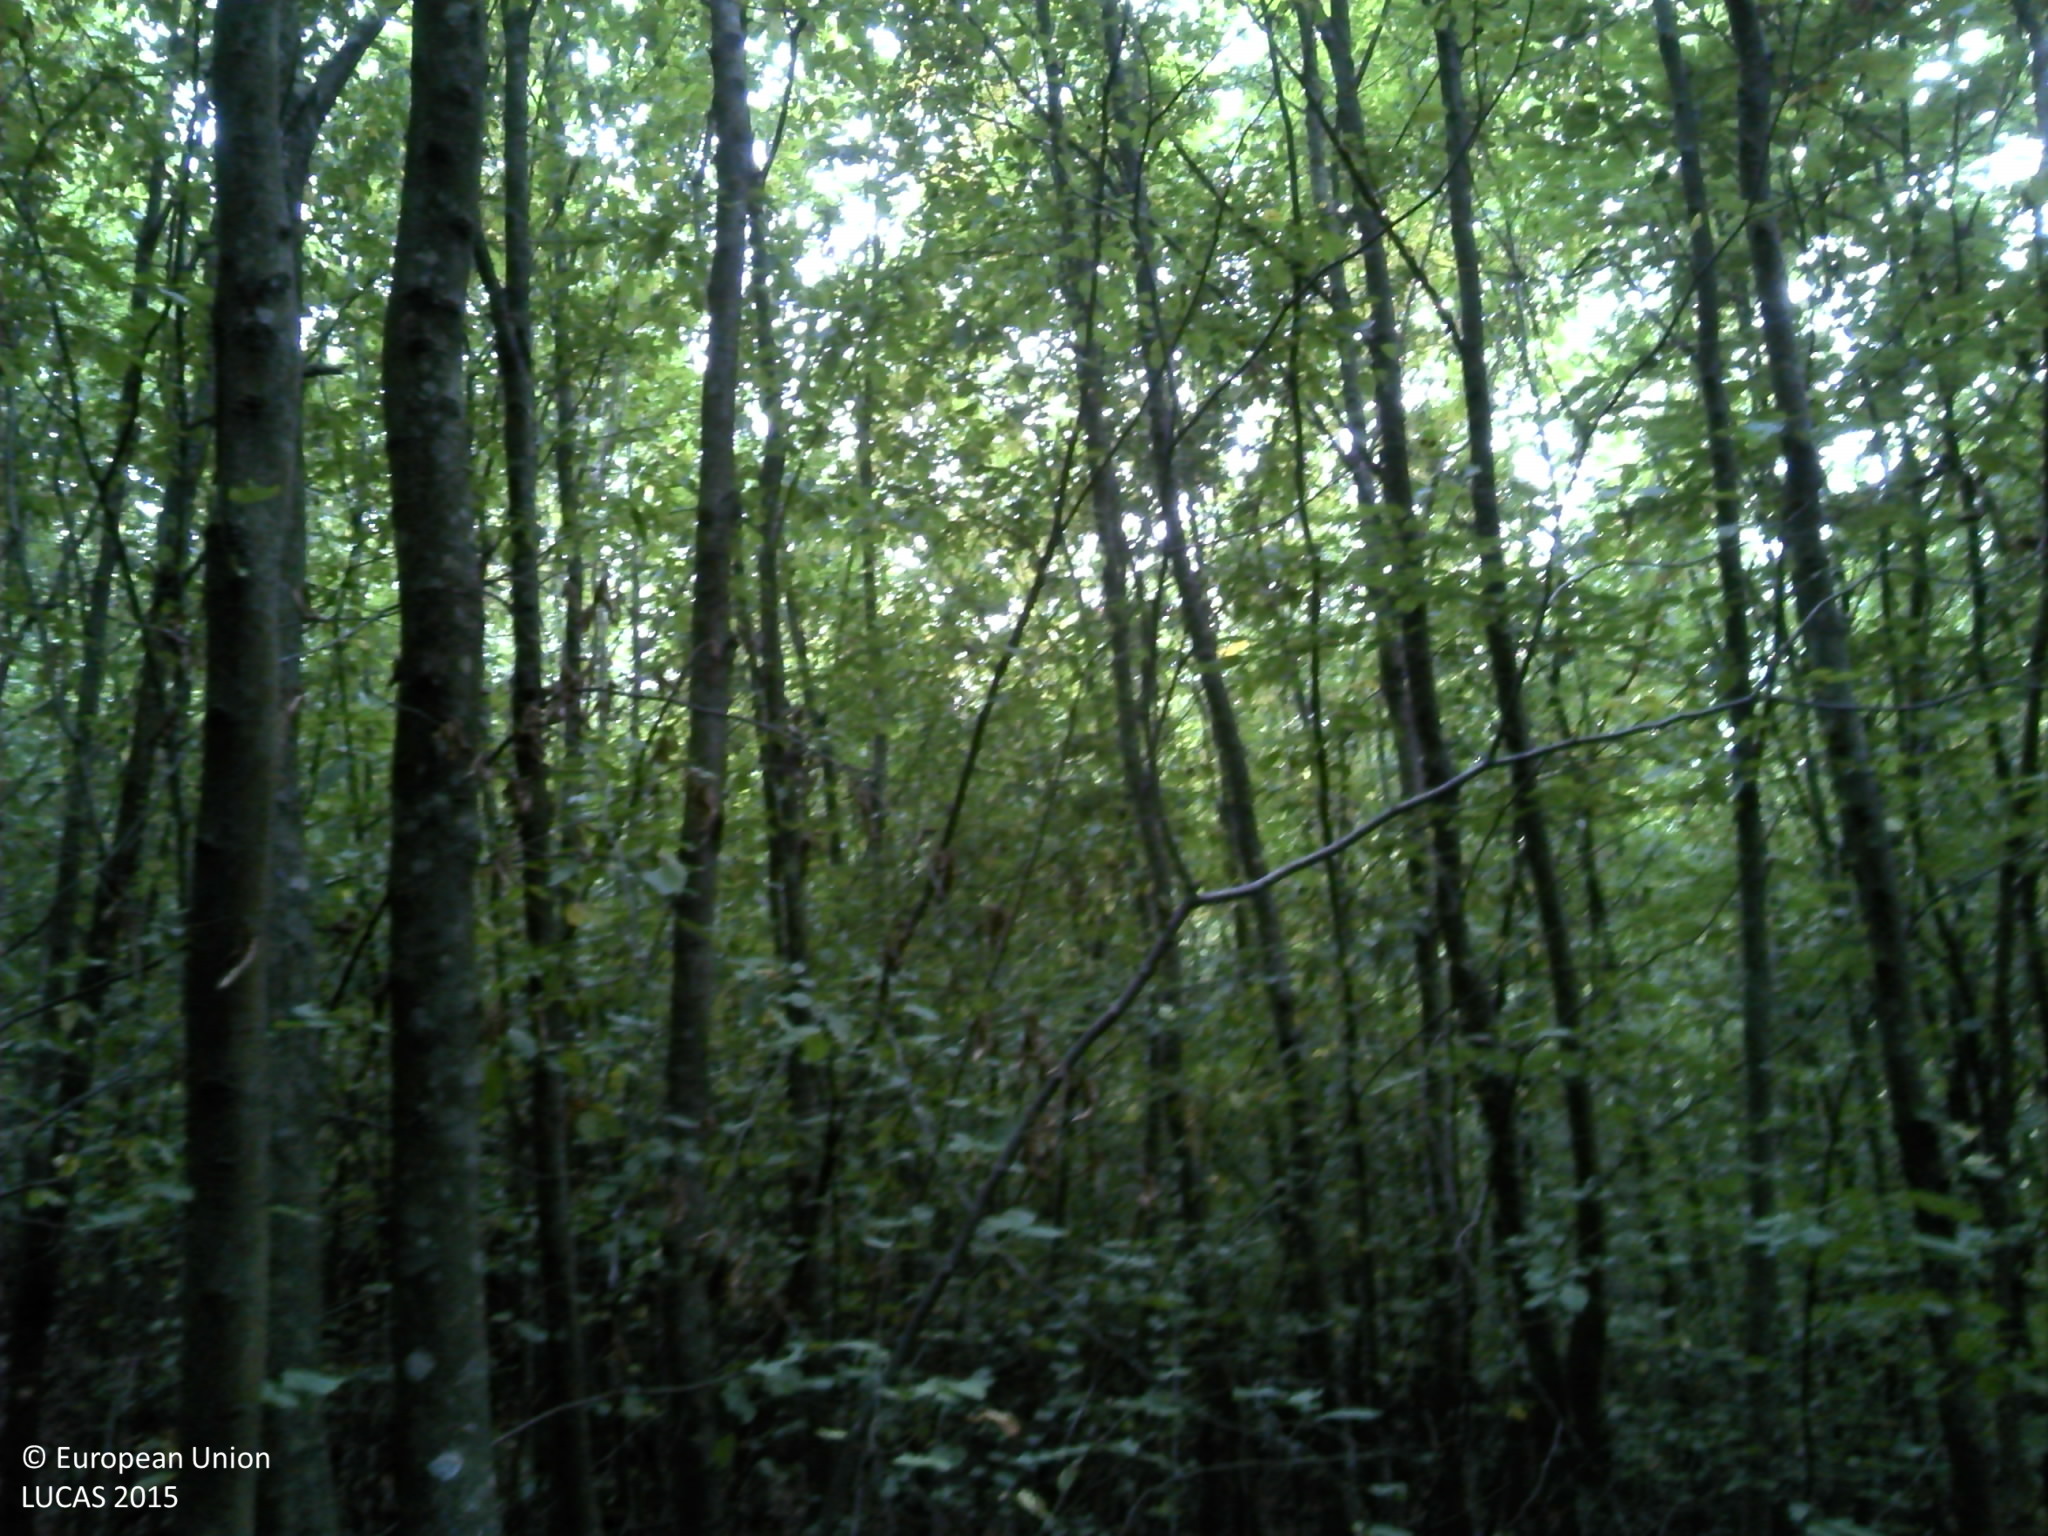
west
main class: Woodland
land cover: Broadleaved woodland
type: beech forest
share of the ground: > 75 %
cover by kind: broadleaved forest trees 100 %
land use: Forestry
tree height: < 5 m
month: August
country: HR
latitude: 45.4146
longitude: 18.0412
